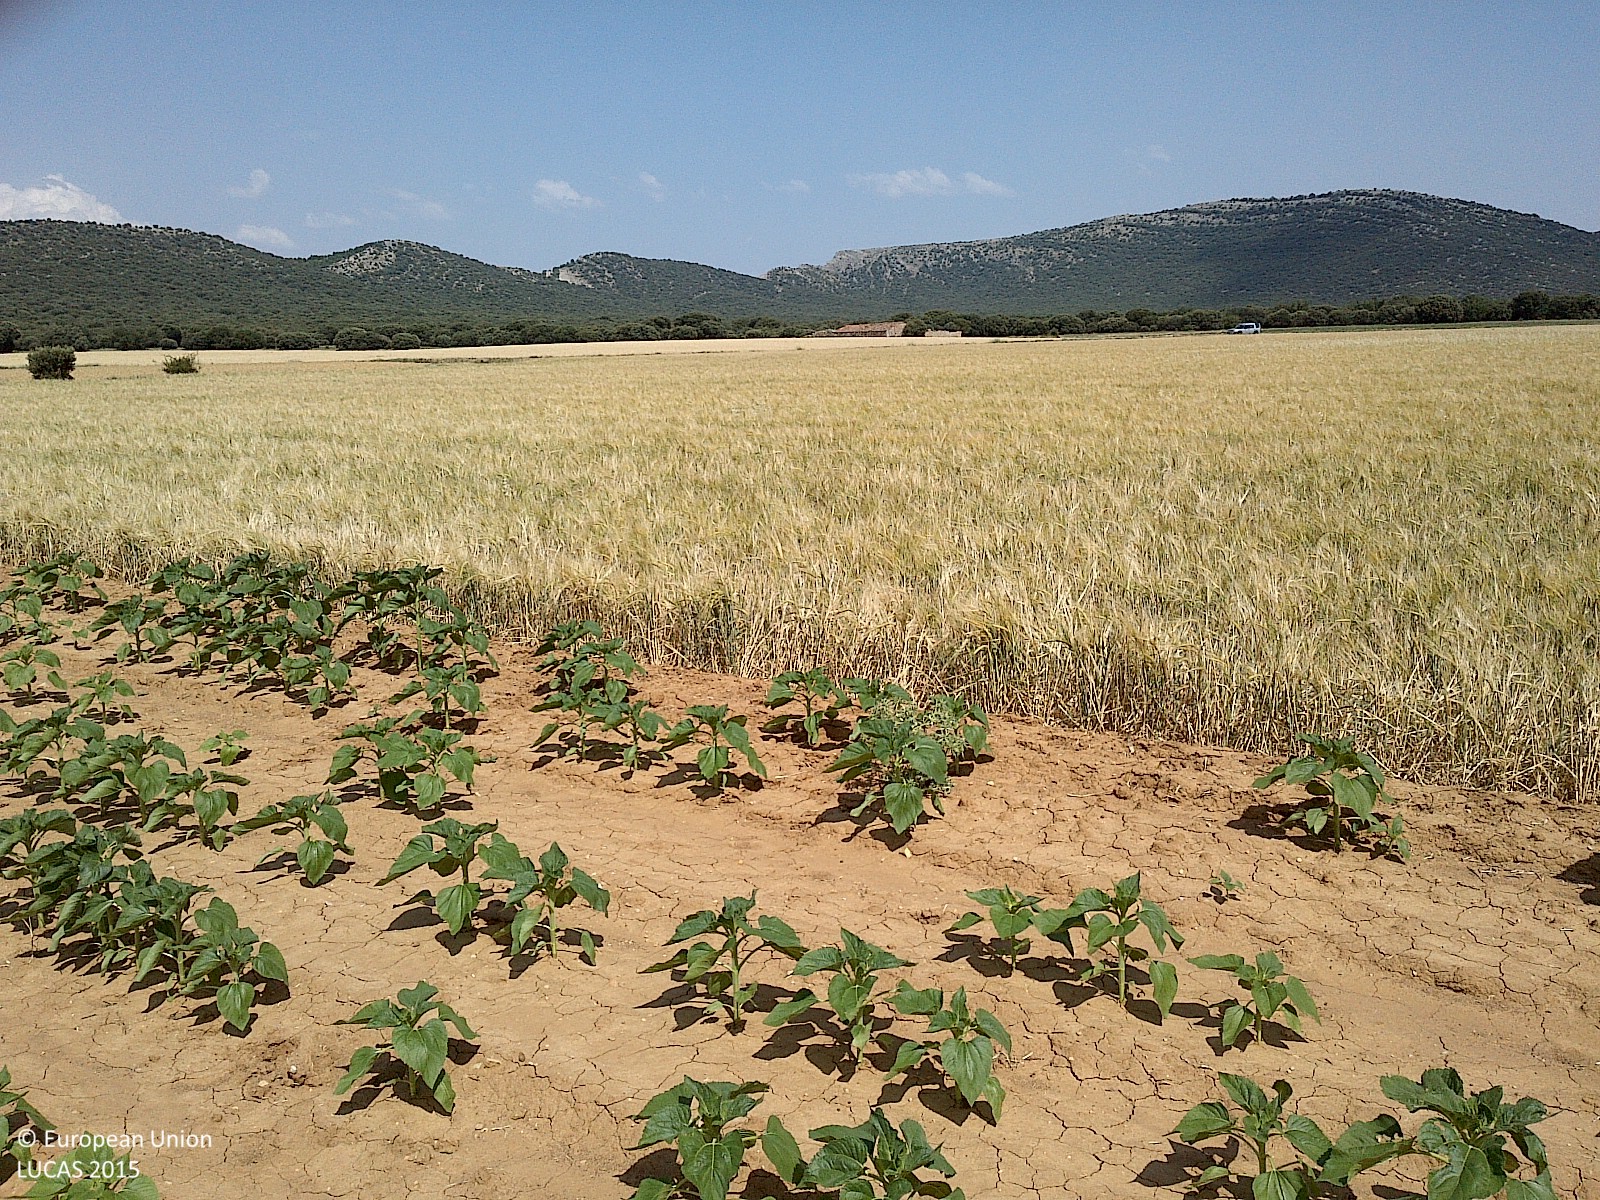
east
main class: Cropland
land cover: Sunflower
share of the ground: < 10 %
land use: Agriculture (excluding fallow land and kitchen gardens)
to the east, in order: Sunflower; Barley; Grass margins; Tracks; Grass margins; Barley
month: July
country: ES
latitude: 41.6135
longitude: -2.1170
